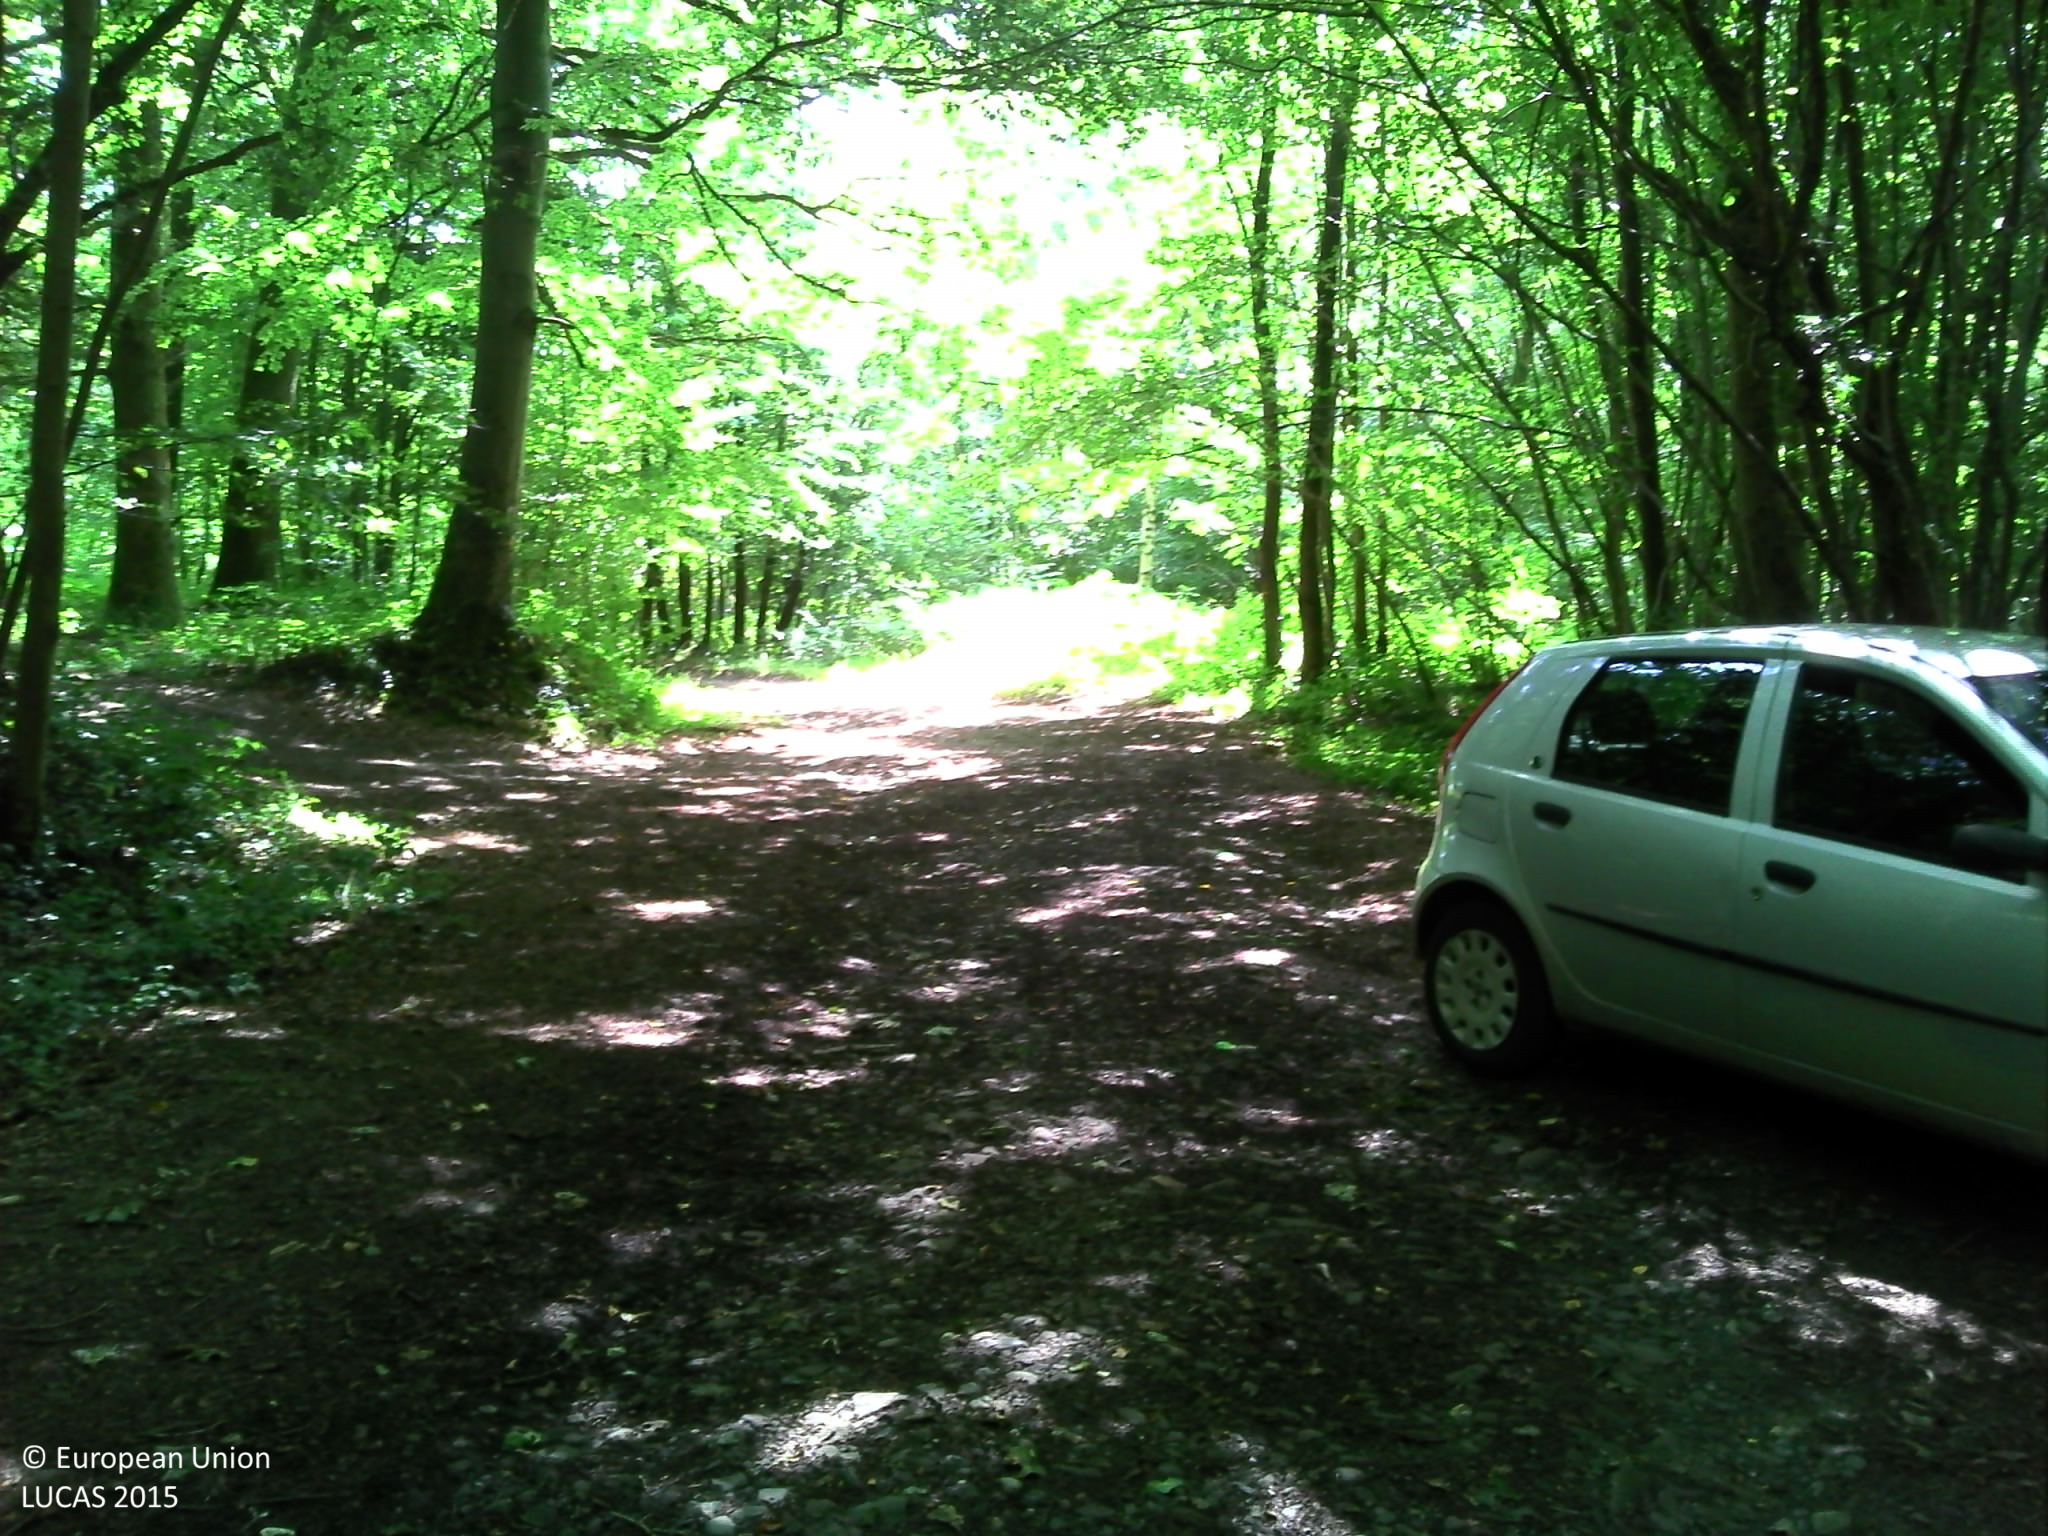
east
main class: Woodland
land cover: Broadleaved woodland
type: mesophytic deciduous forest
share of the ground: > 75 %
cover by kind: broadleaved forest trees 85 %, herbaceous plants 10 %, lichens and mosses 5 %
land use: Forestry
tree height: > 5 m
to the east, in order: Broadleaved woodland; Grassland without tree/shrub cover; Railways; Grassland without tree/shrub cover; Broadleaved woodland
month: August
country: FR
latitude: 50.0145
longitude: 4.1196
